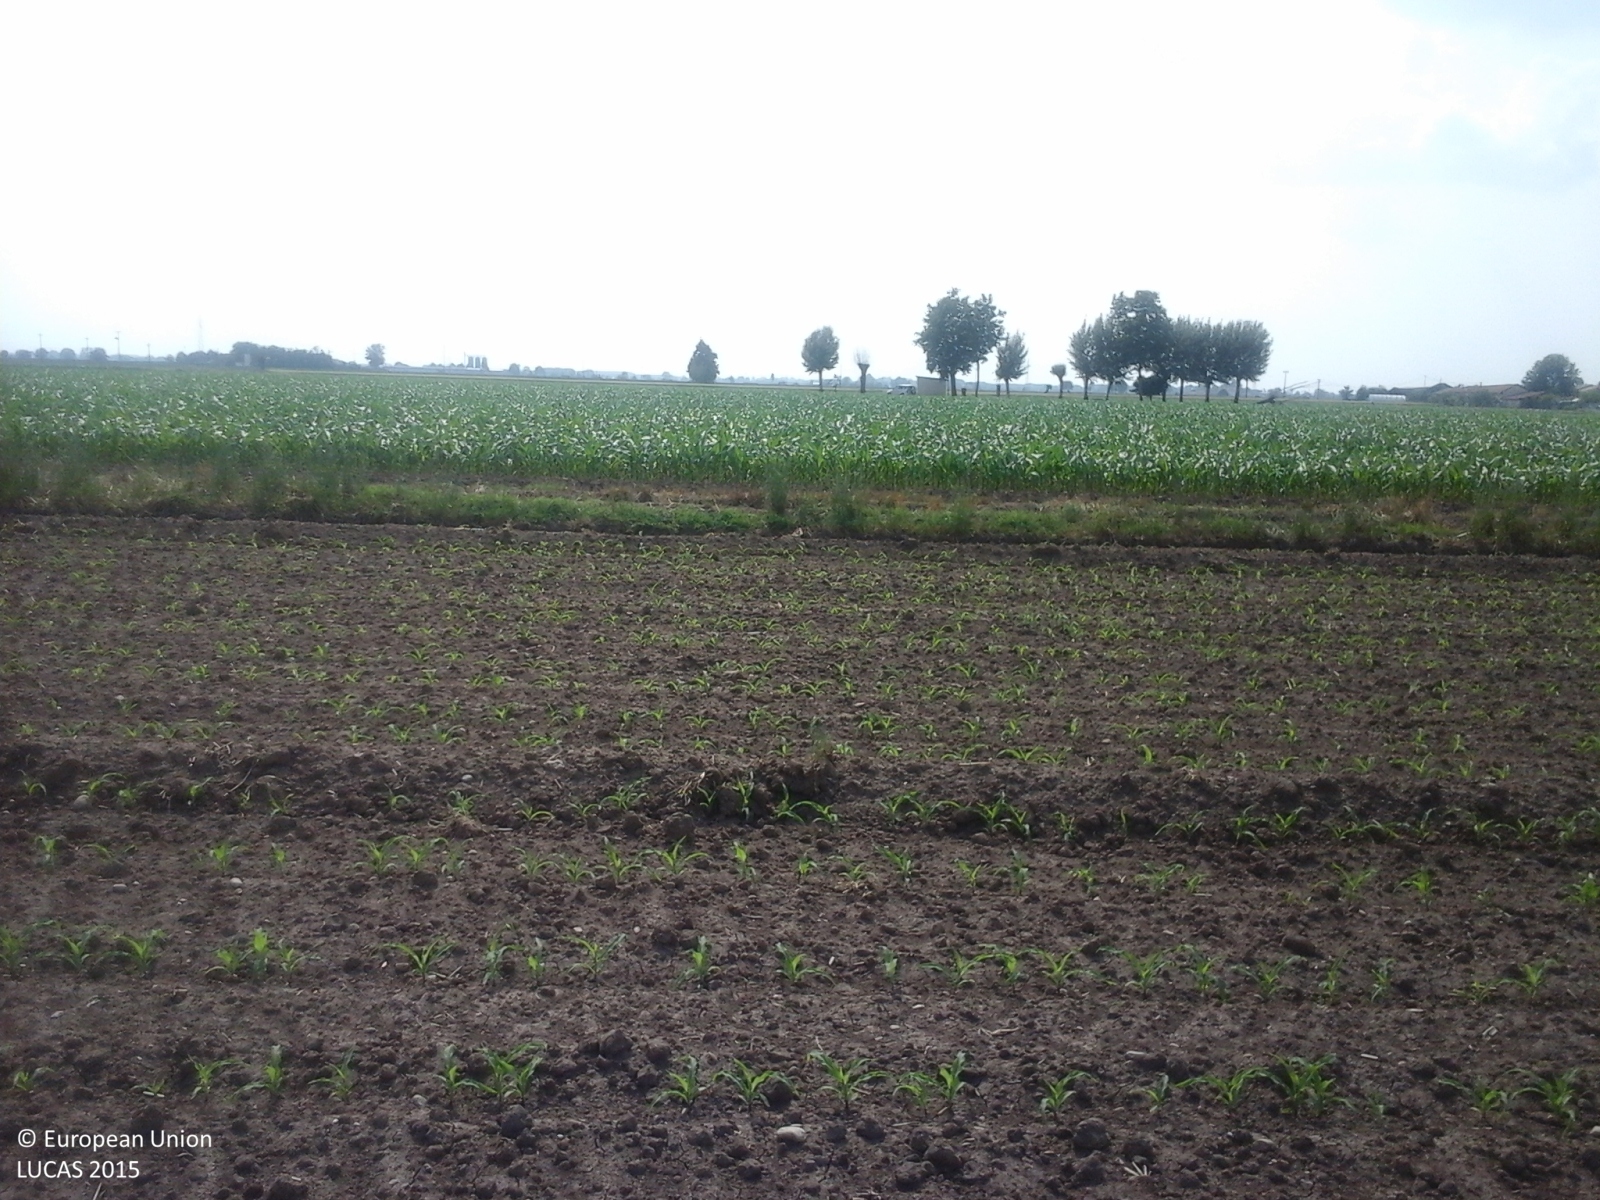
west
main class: Cropland
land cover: Maize
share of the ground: < 10 %
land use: Agriculture (excluding fallow land and kitchen gardens)
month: June
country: IT
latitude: 44.7410
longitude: 7.7438
